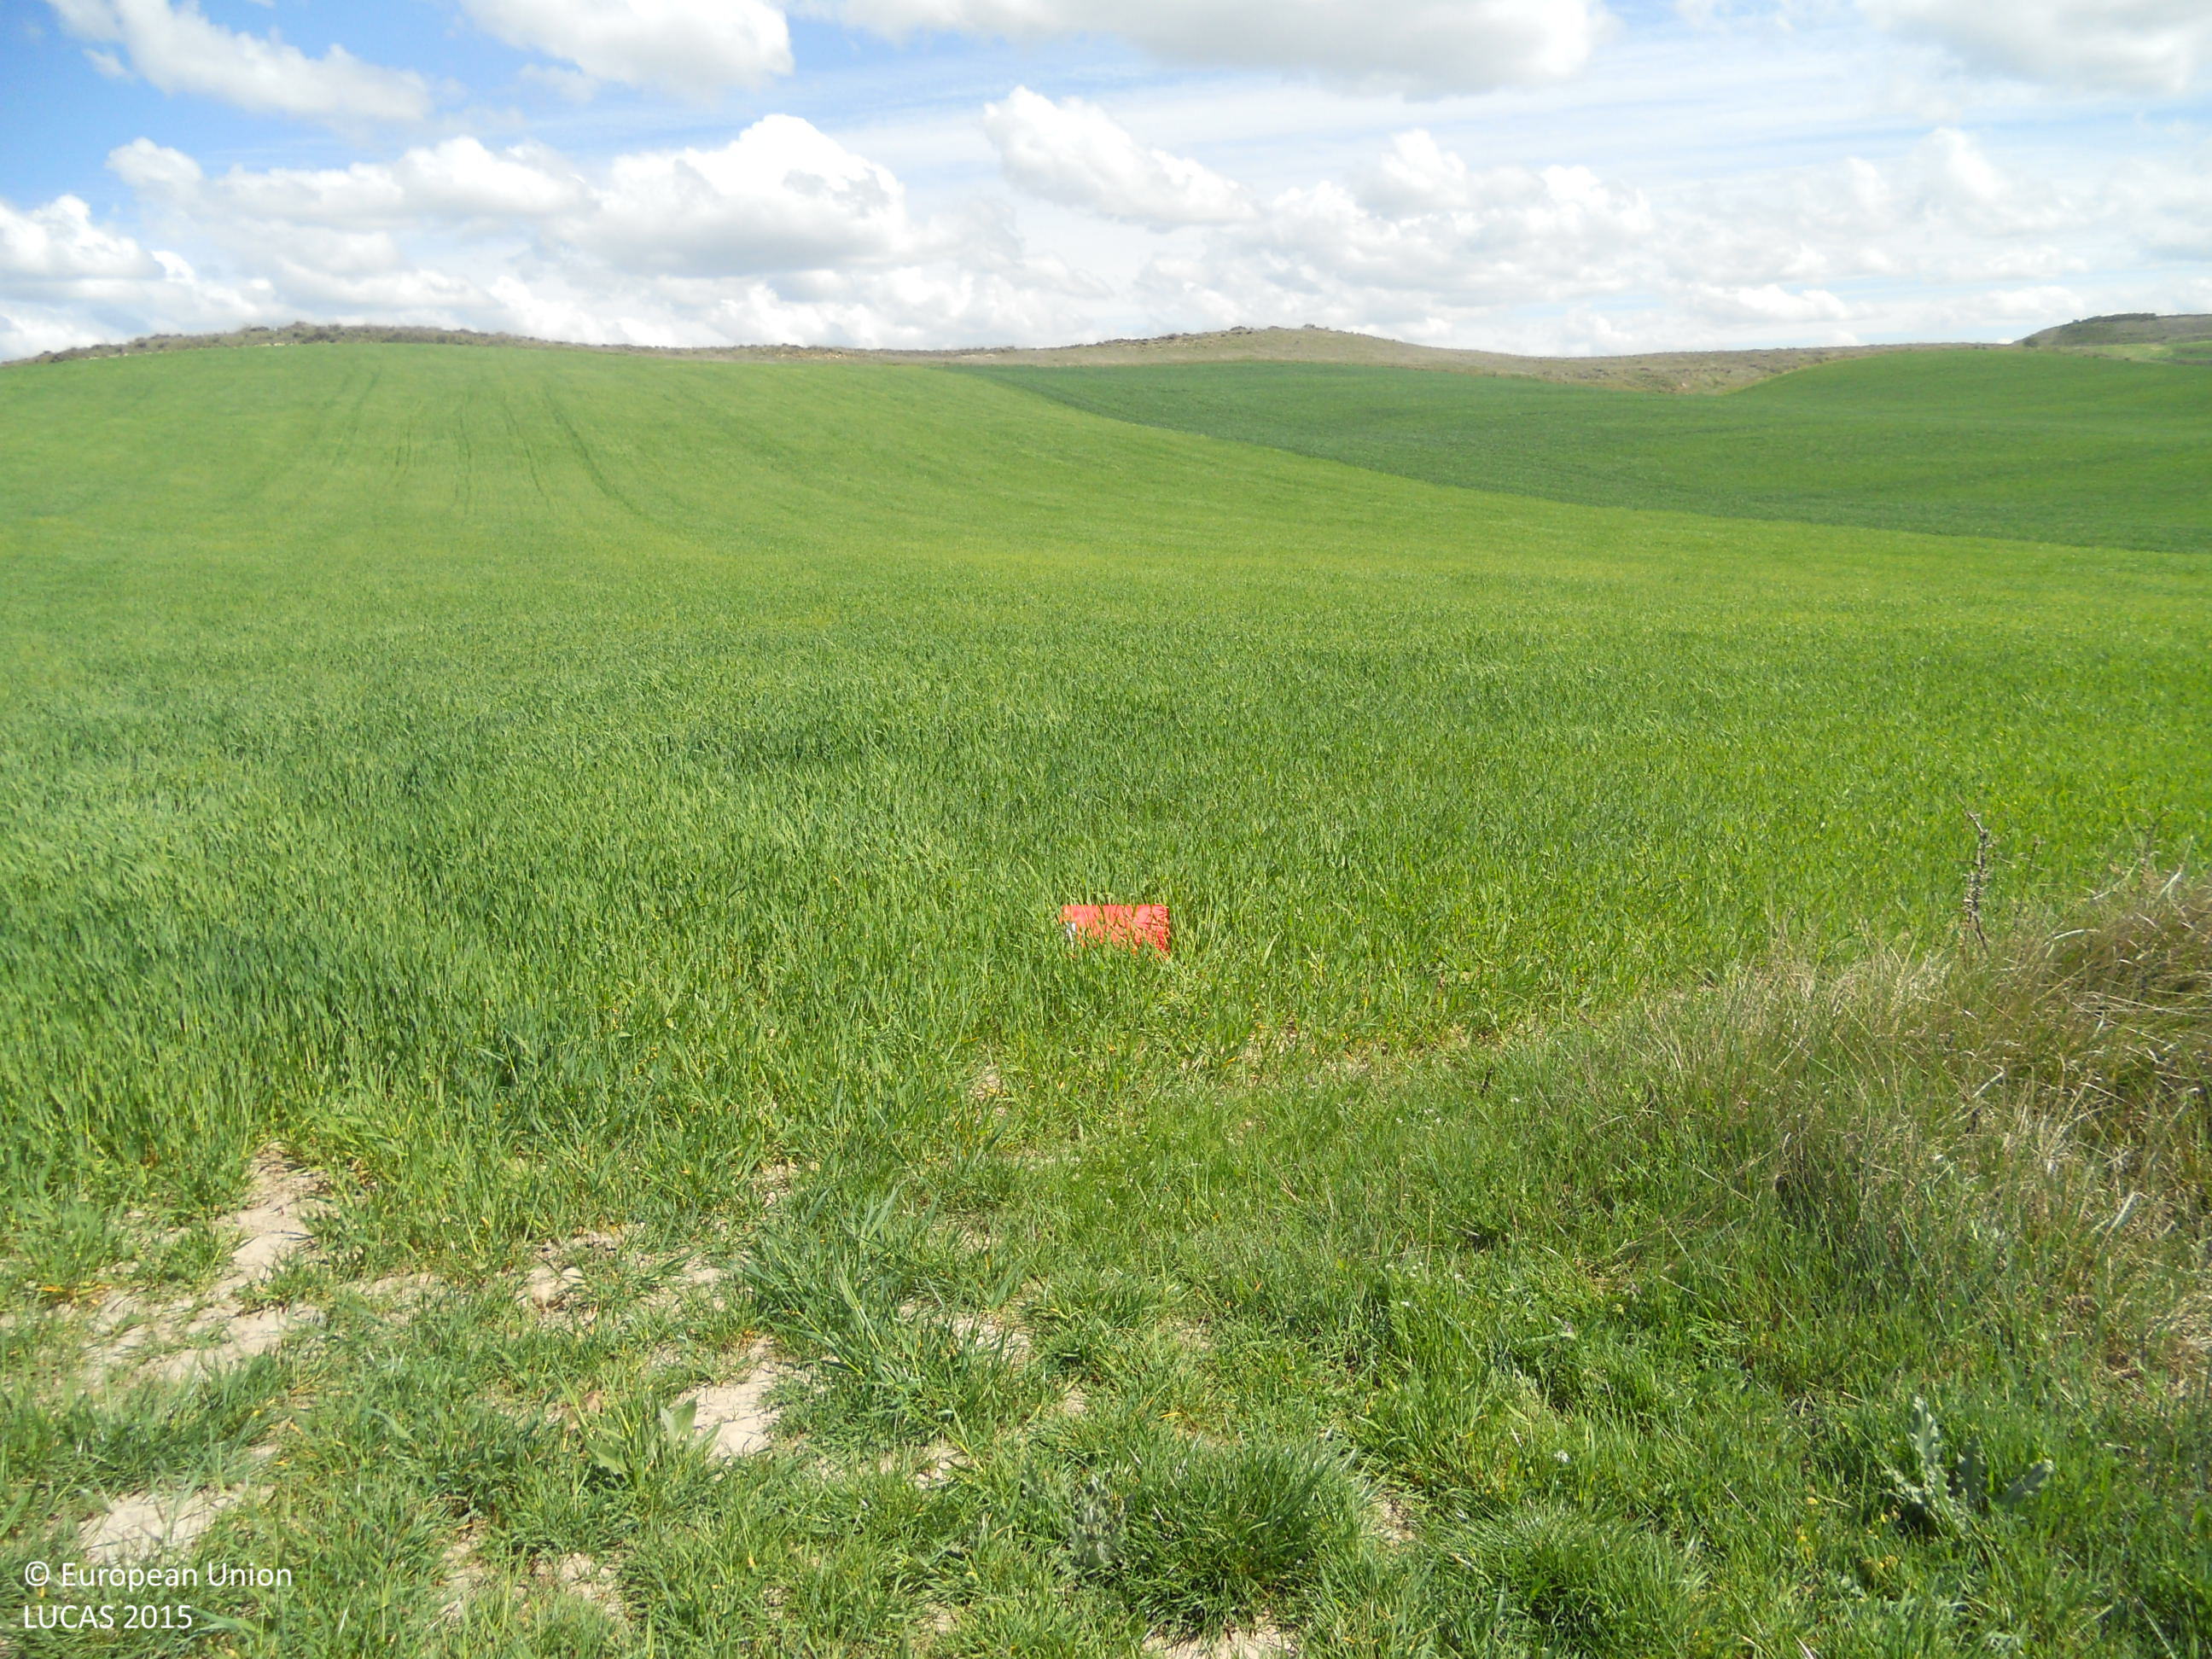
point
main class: Cropland
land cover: Barley
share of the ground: > 75 %
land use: Agriculture (excluding fallow land and kitchen gardens)
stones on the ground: < 10 %
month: April
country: ES
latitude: 42.3034
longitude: -4.2248
